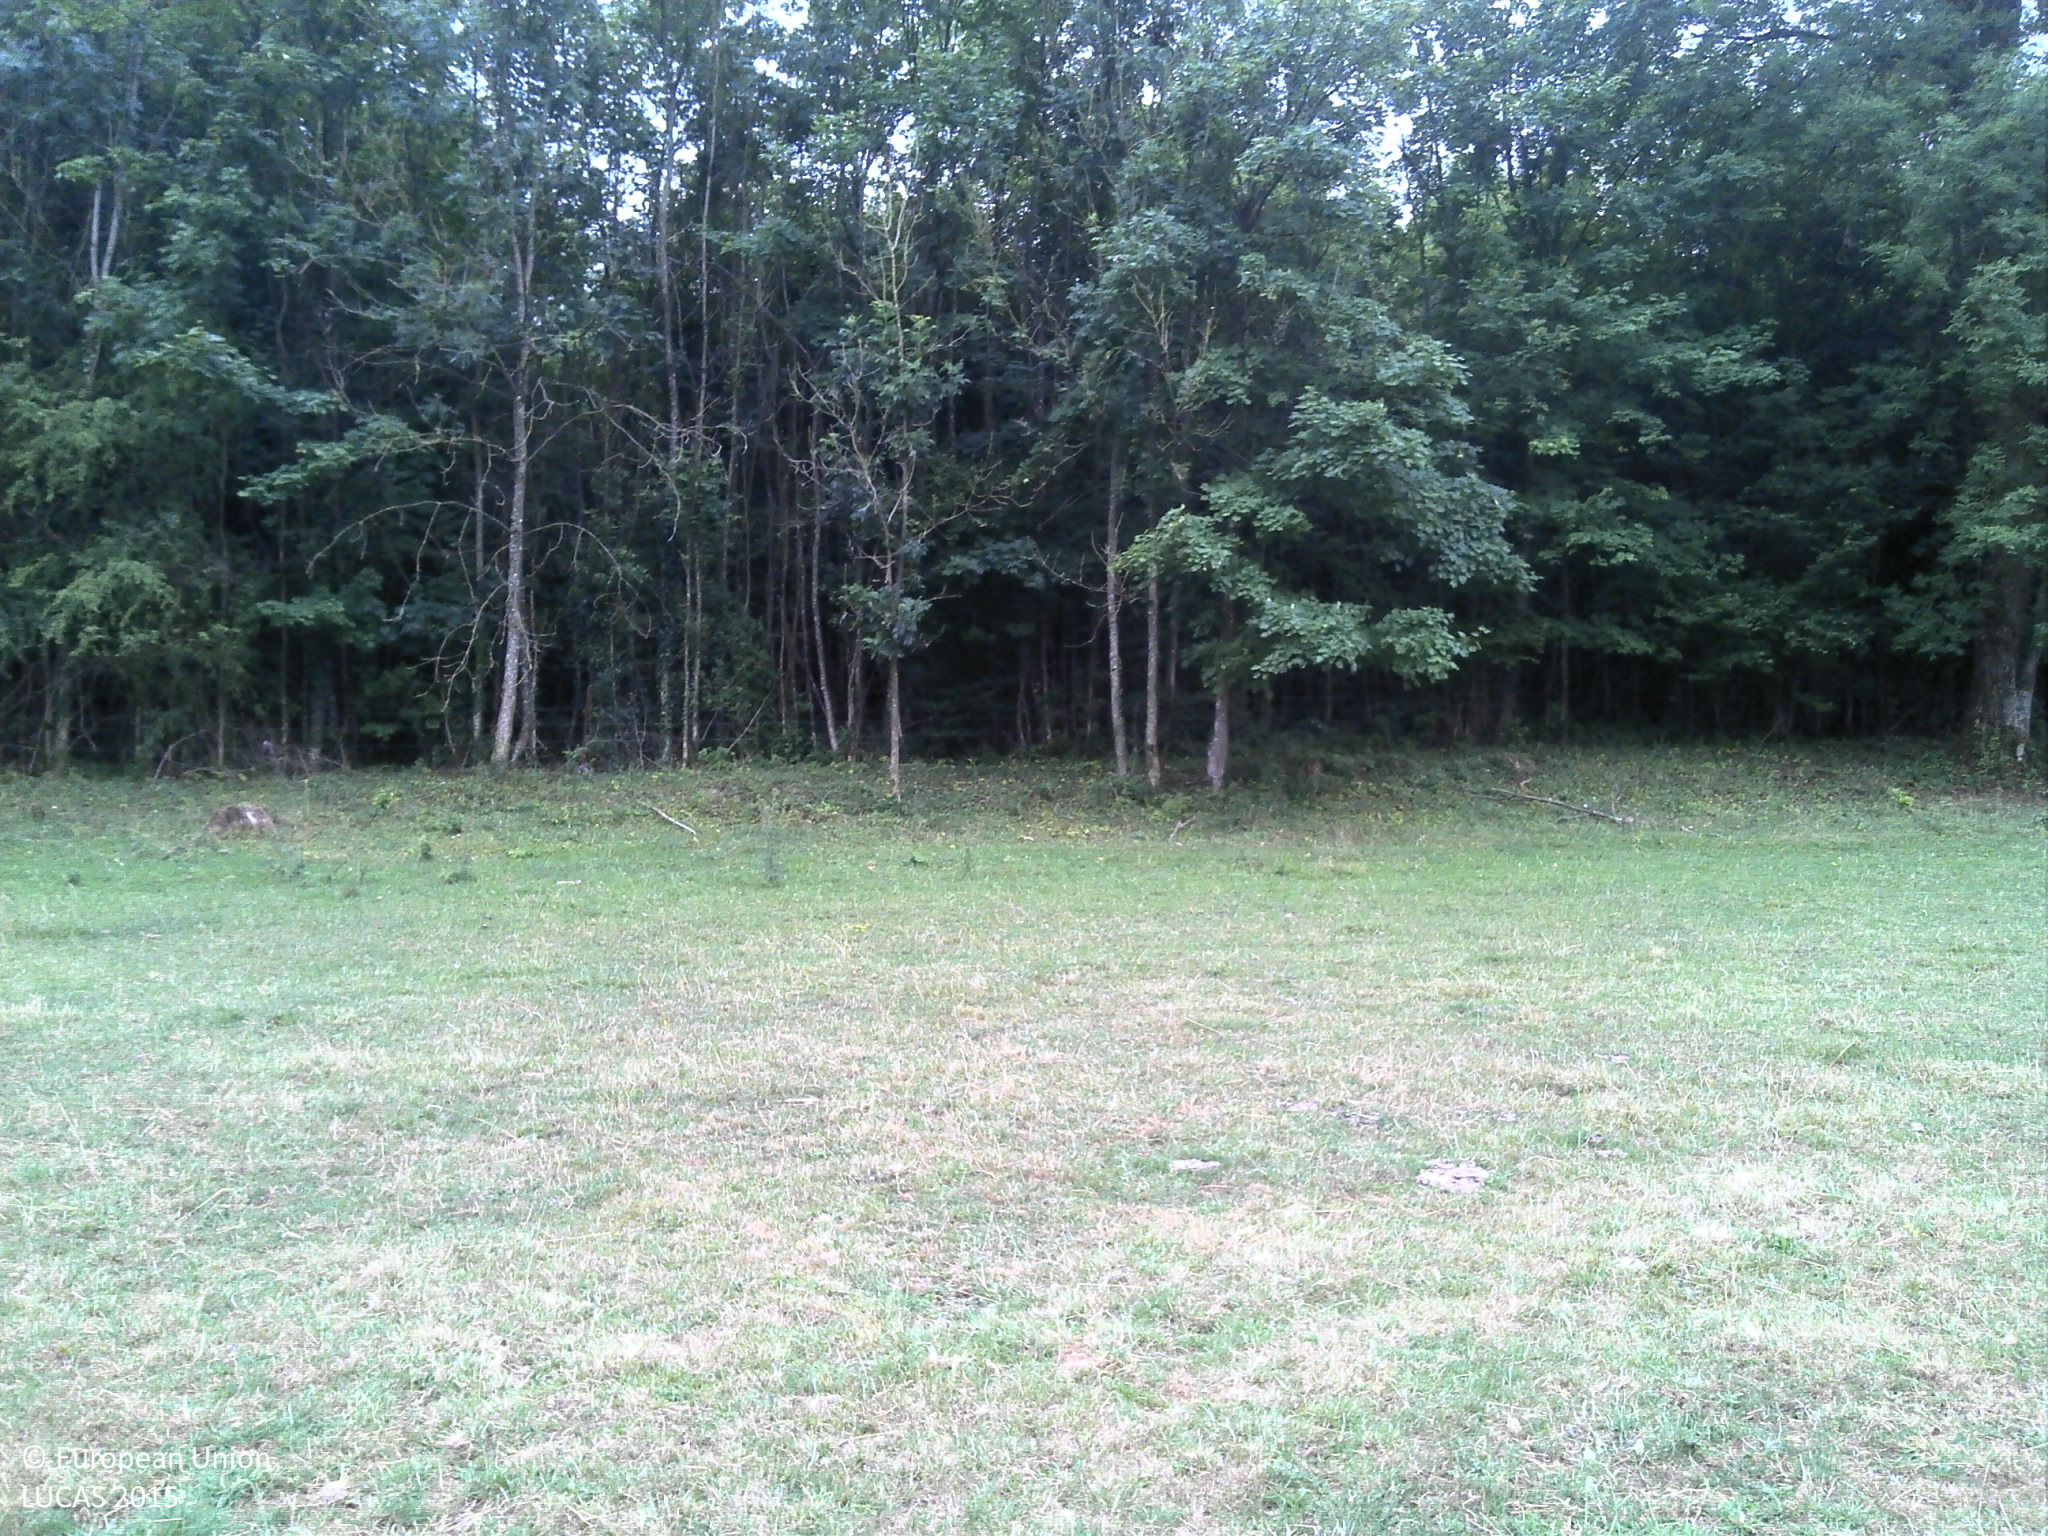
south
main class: Grassland
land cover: Grassland without tree/shrub cover
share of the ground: > 75 %
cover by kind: herbaceous plants 100 %
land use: Agriculture (excluding fallow land and kitchen gardens)
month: July
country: FR
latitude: 49.7332
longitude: 4.6271
